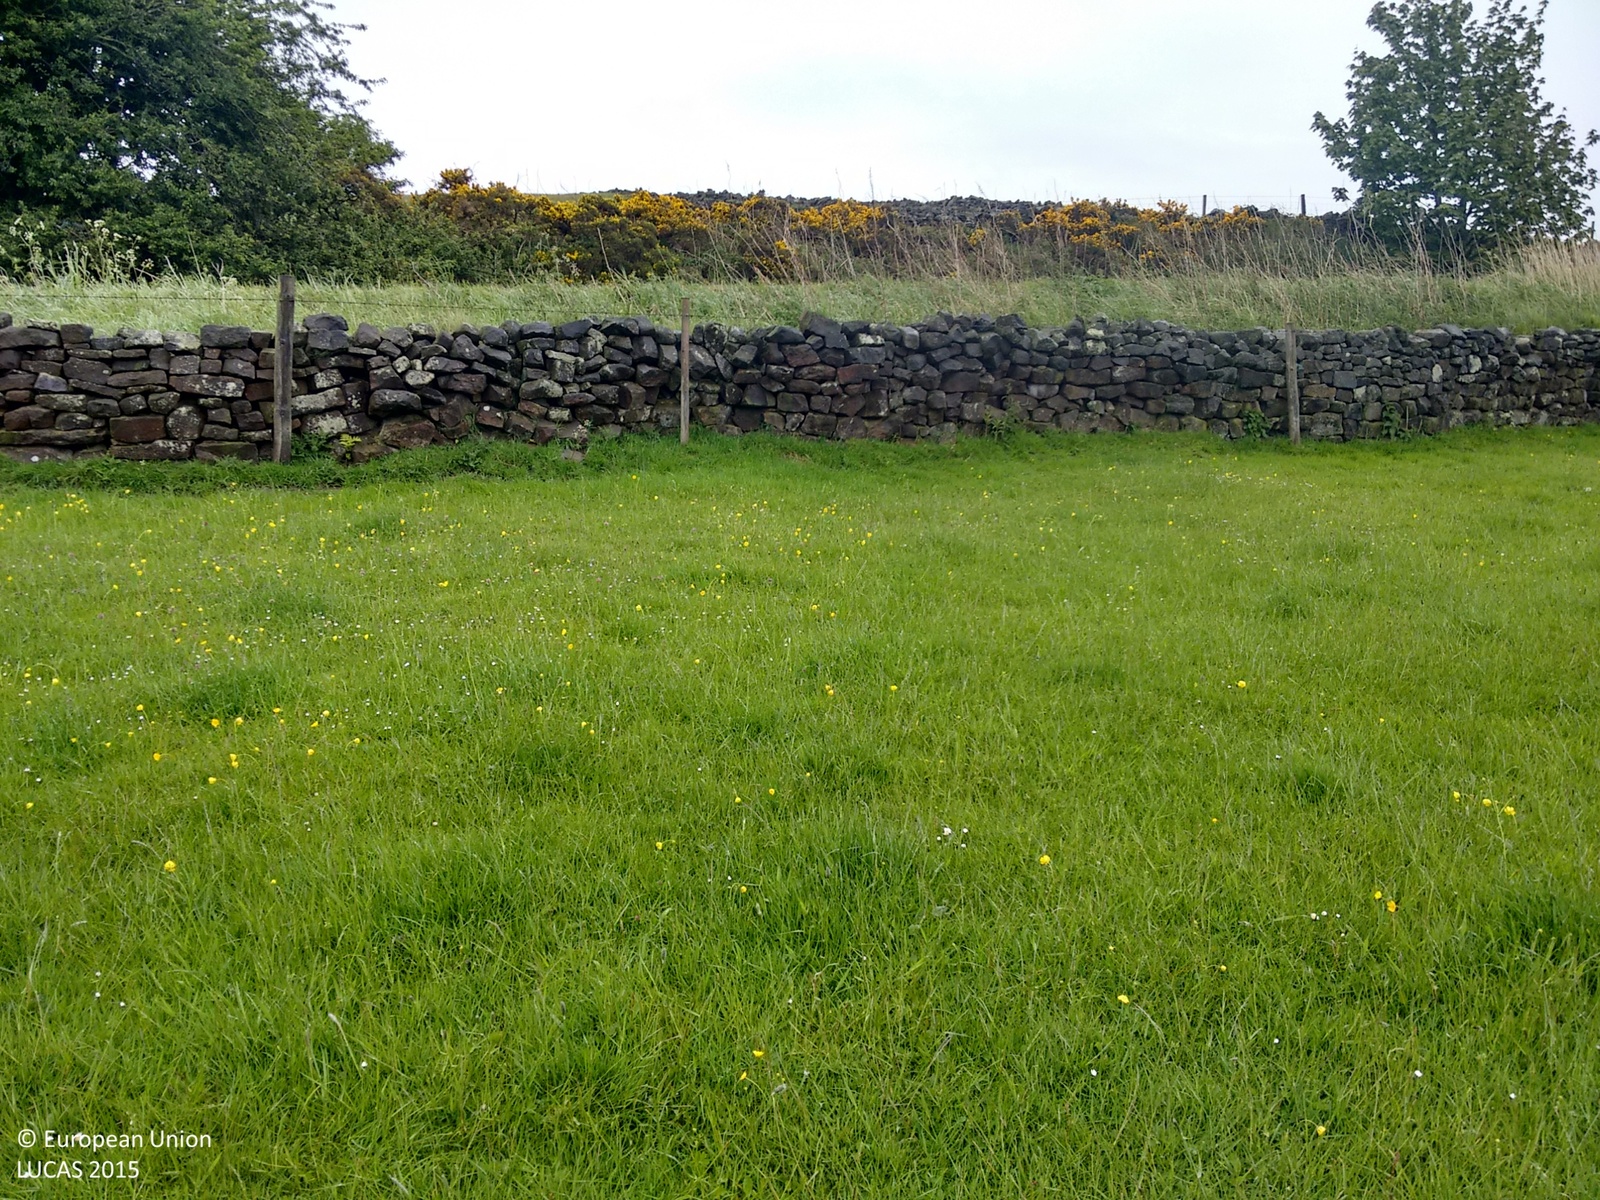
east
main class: Grassland
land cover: Grassland without tree/shrub cover
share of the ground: > 75 %
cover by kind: herbaceous plants 100 %
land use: Agriculture (excluding fallow land and kitchen gardens)
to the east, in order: Grassland without tree/shrub cover; Fences; Dry stone walls; Grass margins; Paved roads, cycling and walking lanes; Grass margins; Dry stone walls; Fences; Grassland without tree/shrub cover; Dry stone walls; Grassland without tree/shrub cover; Dry stone walls; Fences; Grassland without tree/shrub cover; Dry stone walls; Fences; Grassland without tree/shrub cover
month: May
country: GB
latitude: 53.9789
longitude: -1.6862
